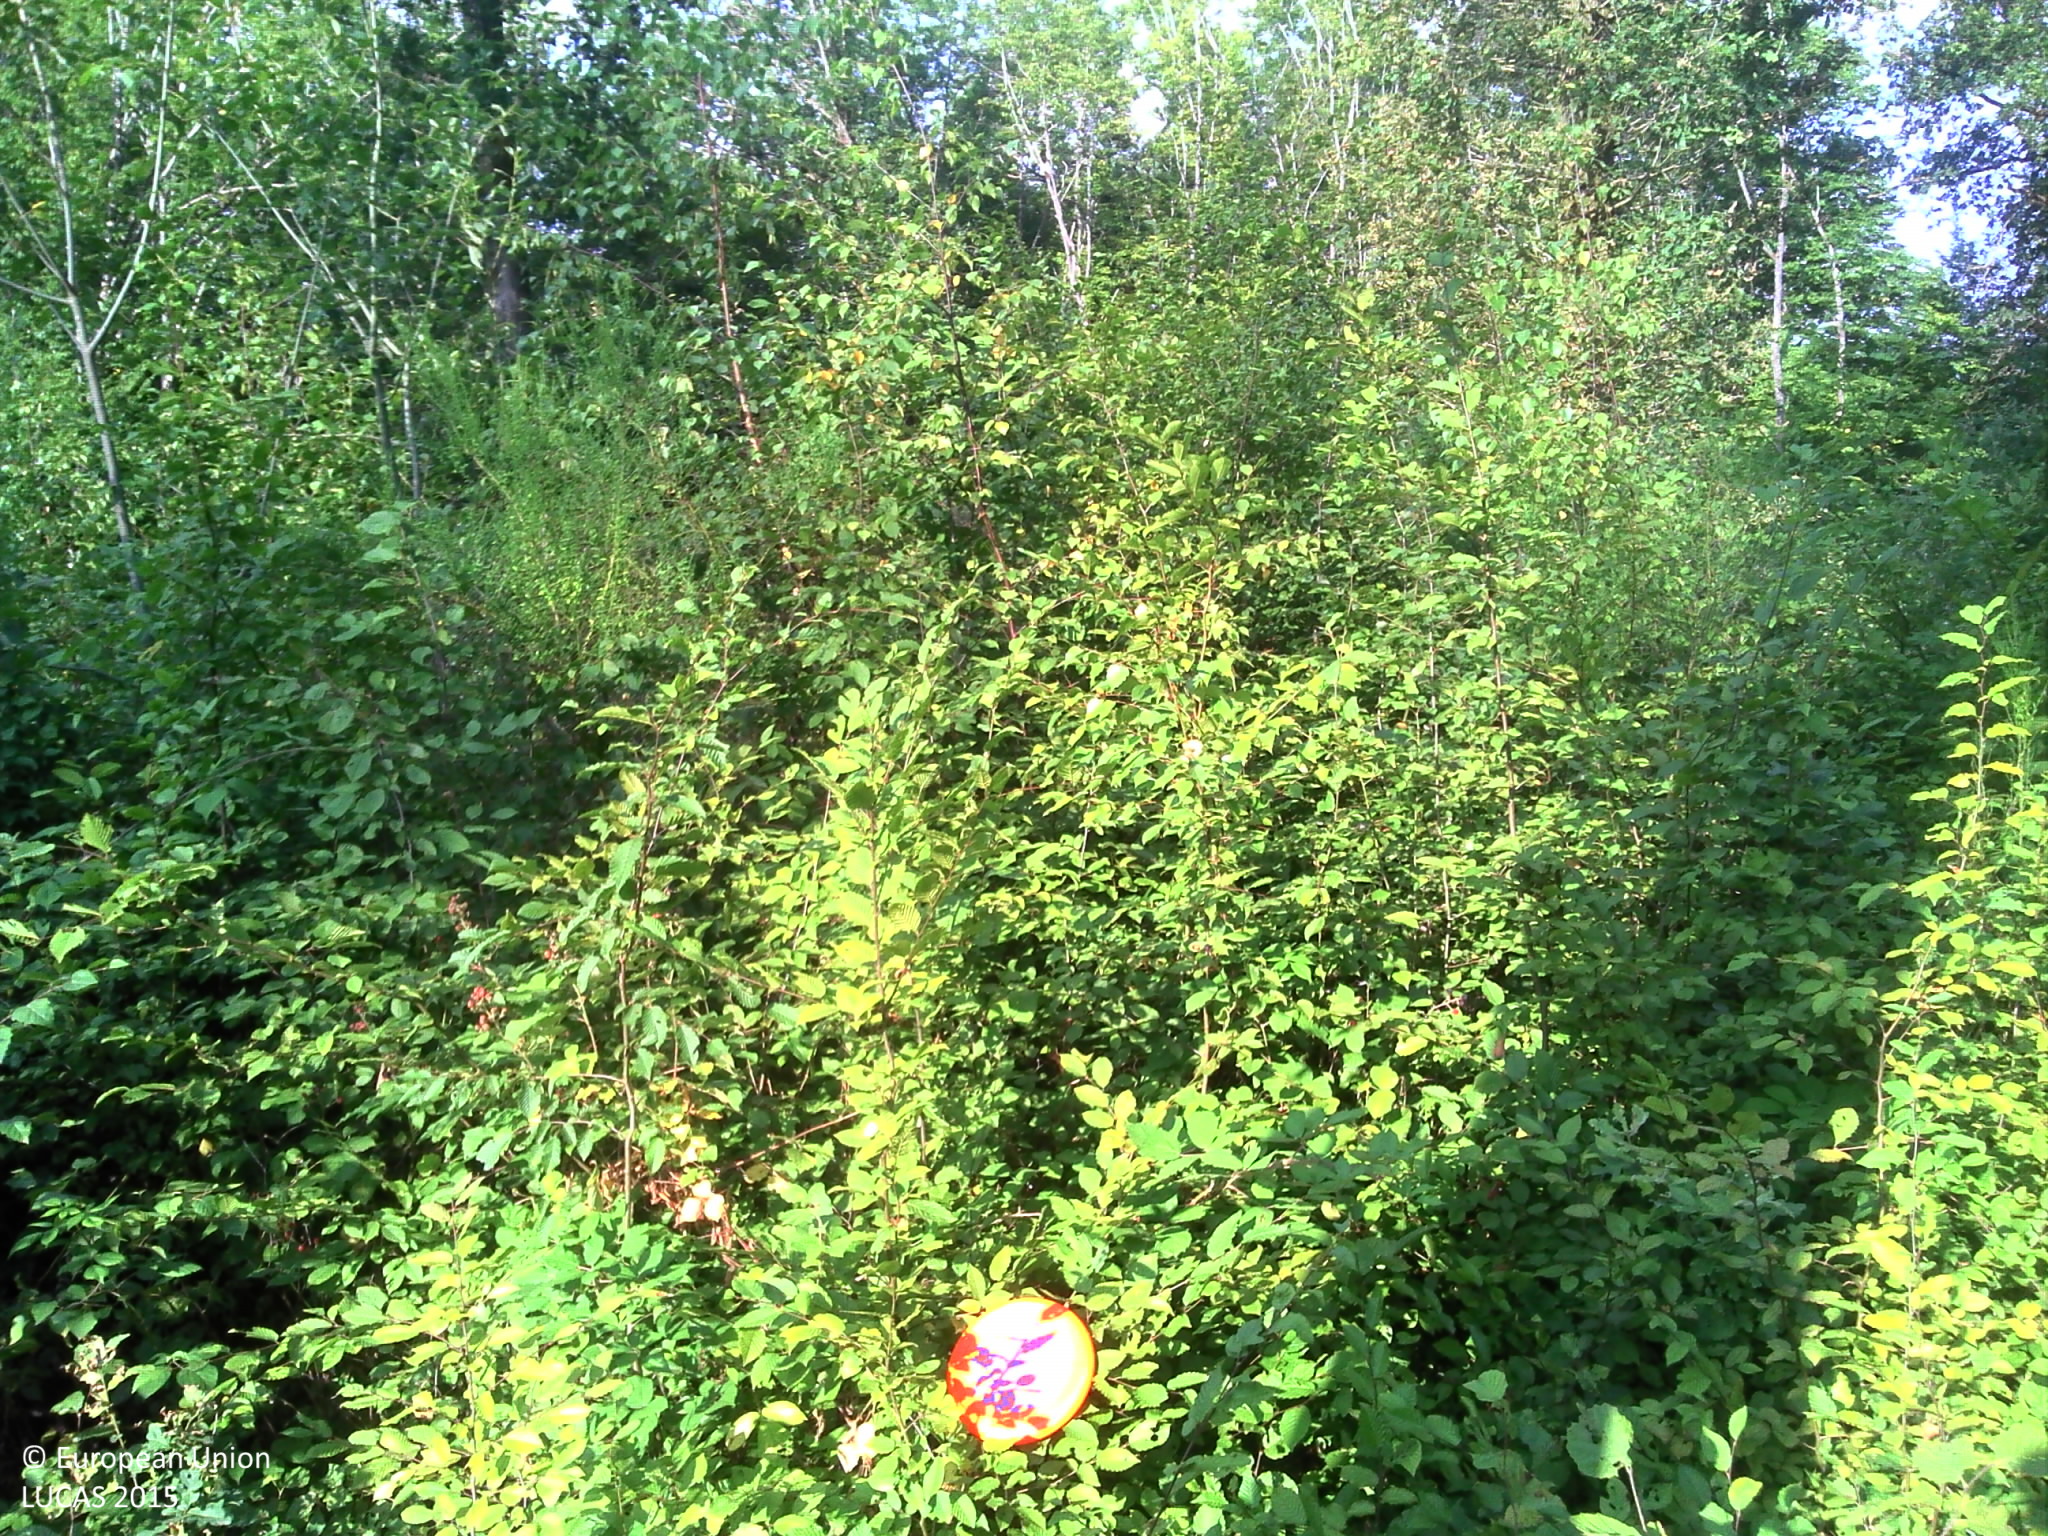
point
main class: Woodland
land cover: Broadleaved woodland
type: mesophytic deciduous forest
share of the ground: > 75 %
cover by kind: broadleaved forest trees 80 %, herbaceous plants 15 %, lichens and mosses 5 %
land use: Semi-natural and natural areas not in use
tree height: > 5 m
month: August
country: FR
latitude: 47.0324
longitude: 4.3545
